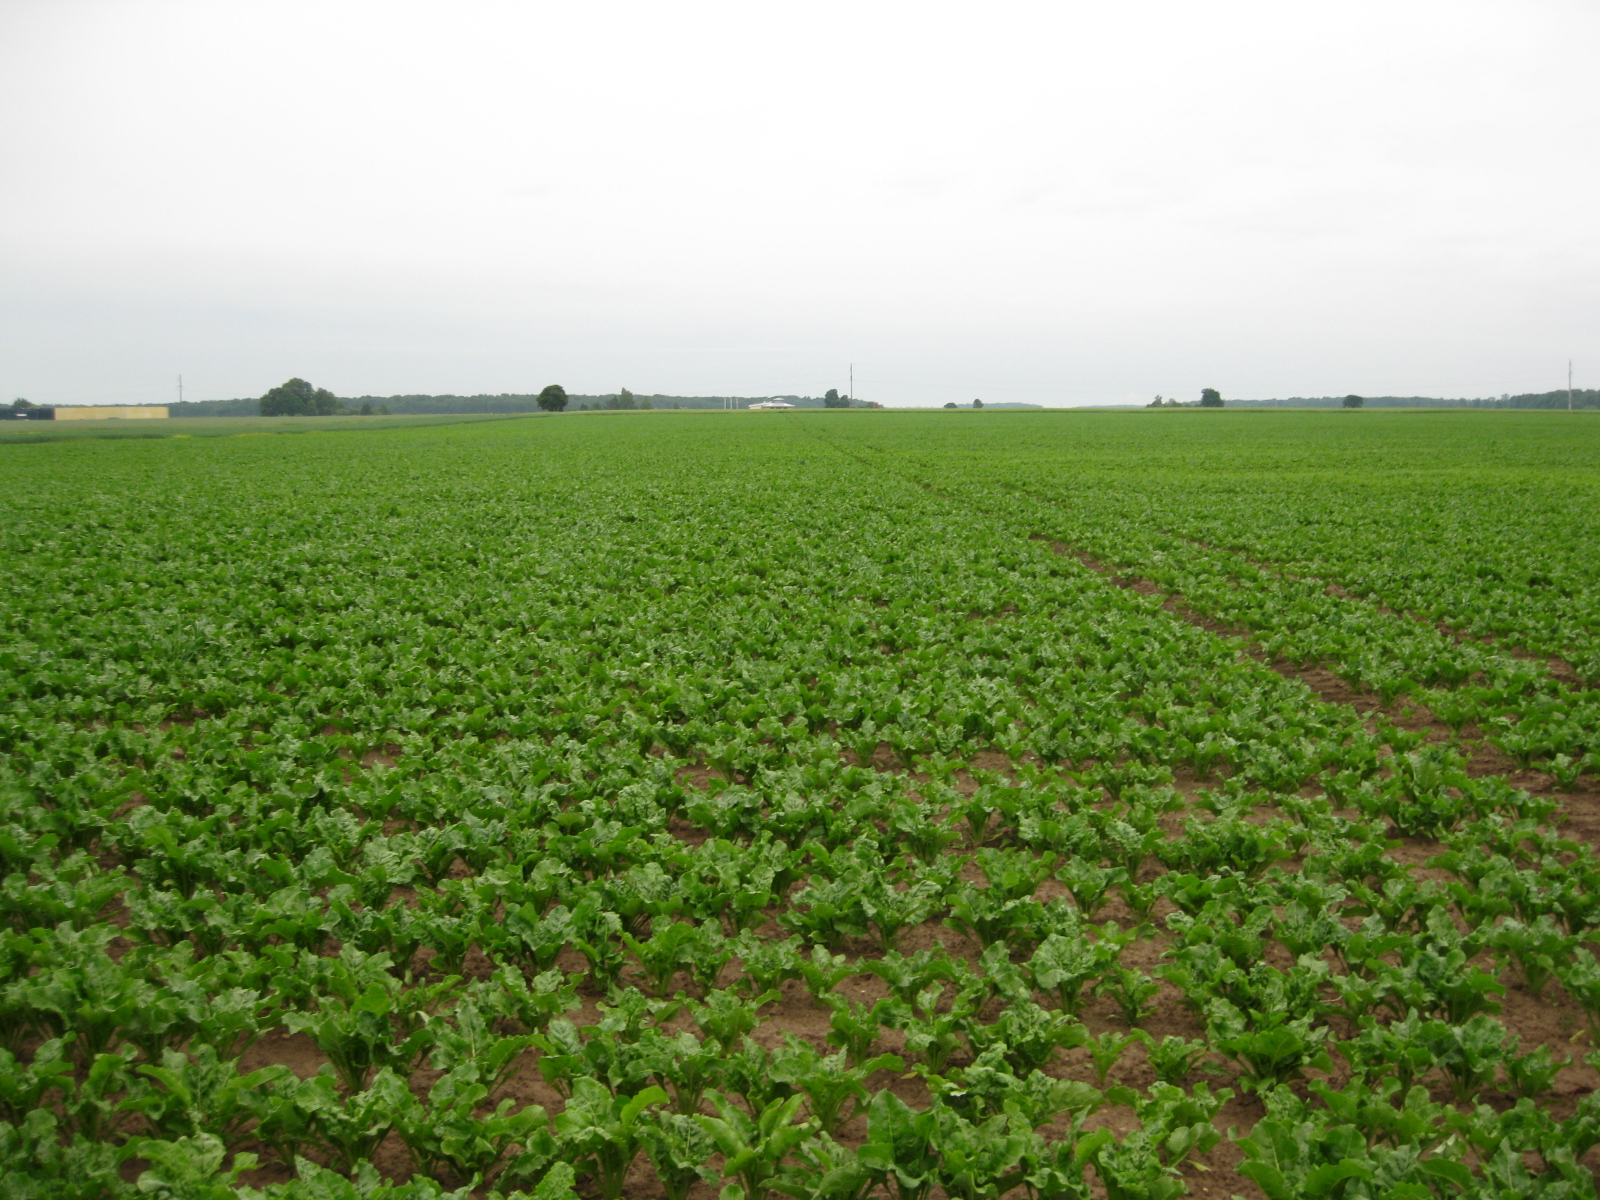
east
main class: Cropland
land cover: Sugar beet
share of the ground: 50 - 75 %
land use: Agriculture (excluding fallow land and kitchen gardens)
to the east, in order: Sugar beet
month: June
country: LT
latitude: 55.1612
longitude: 23.9809
